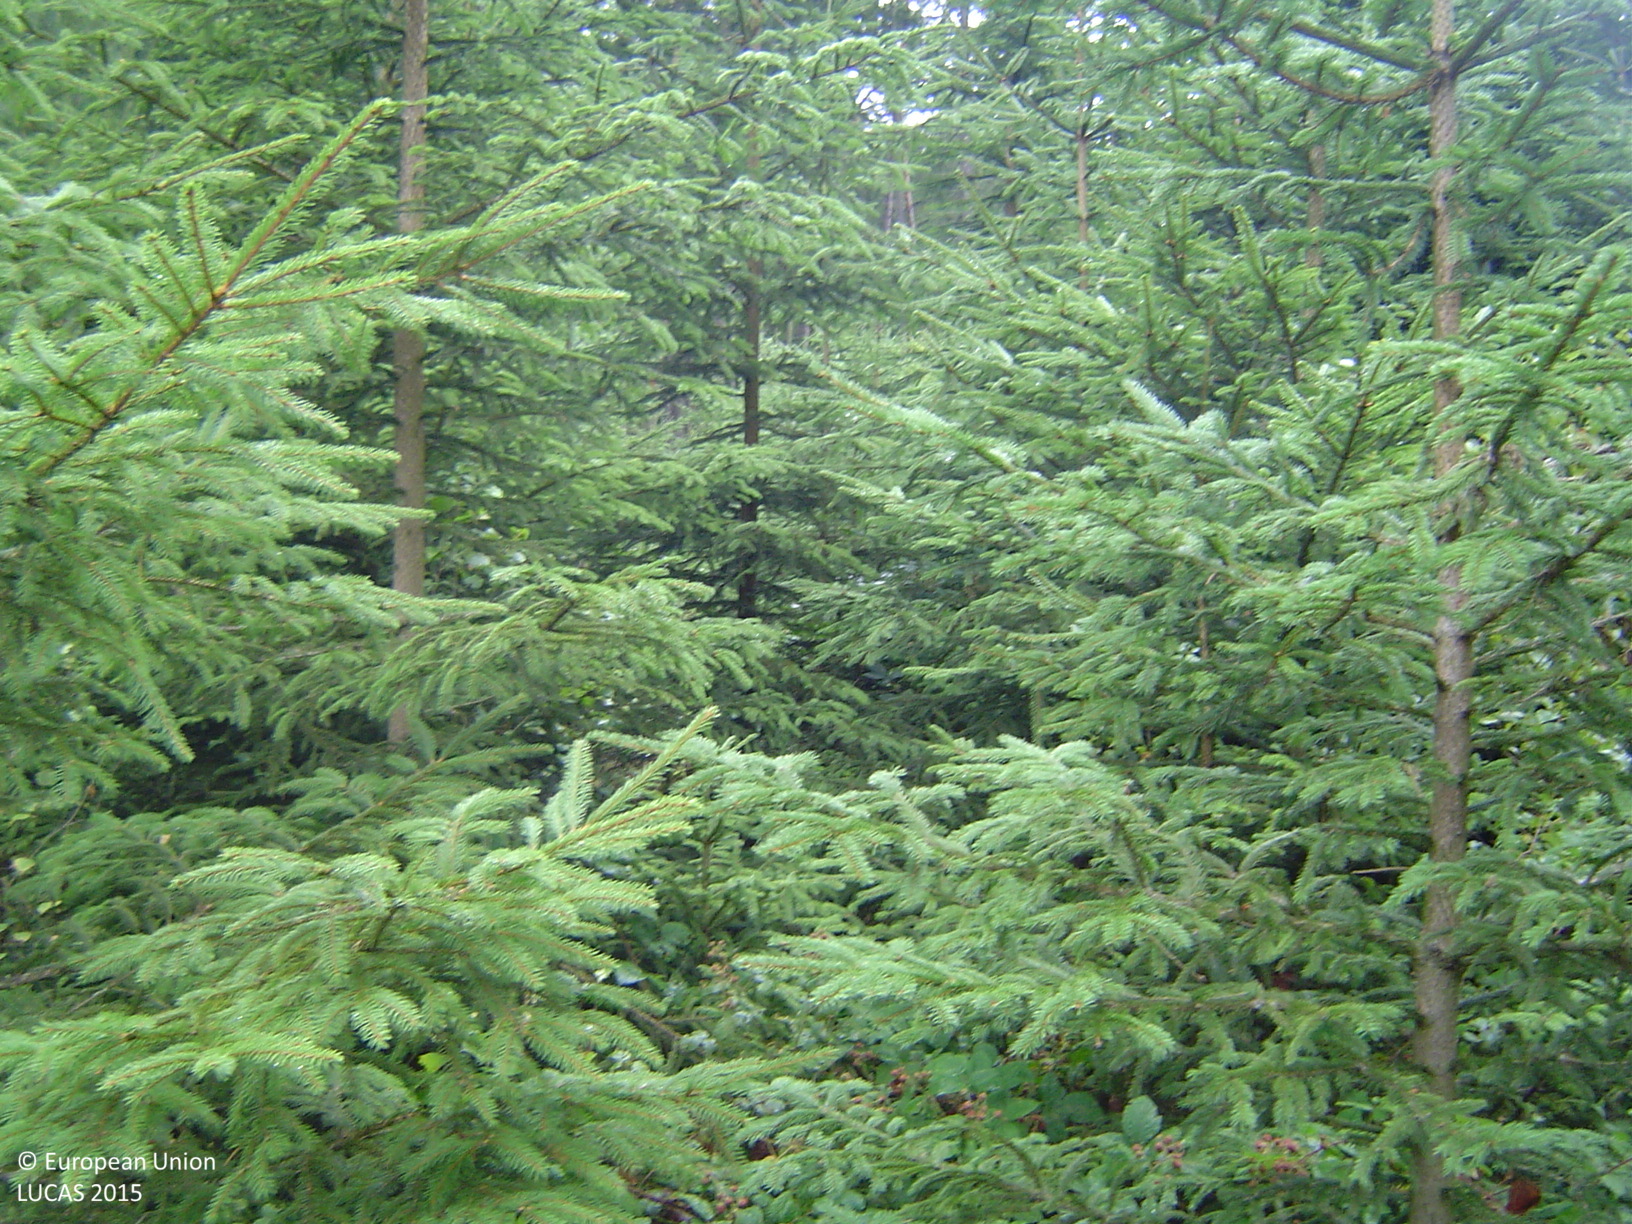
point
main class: Woodland
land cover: Spruce dominated coniferous woodland
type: hemiboreal forest and nemoral coniferous forest and mixed broadleaved-coniferous forest
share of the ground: > 75 %
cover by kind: coniferous forest trees 100 %
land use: Forestry
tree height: > 5 m
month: August
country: CZ
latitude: 49.5628
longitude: 13.8026
